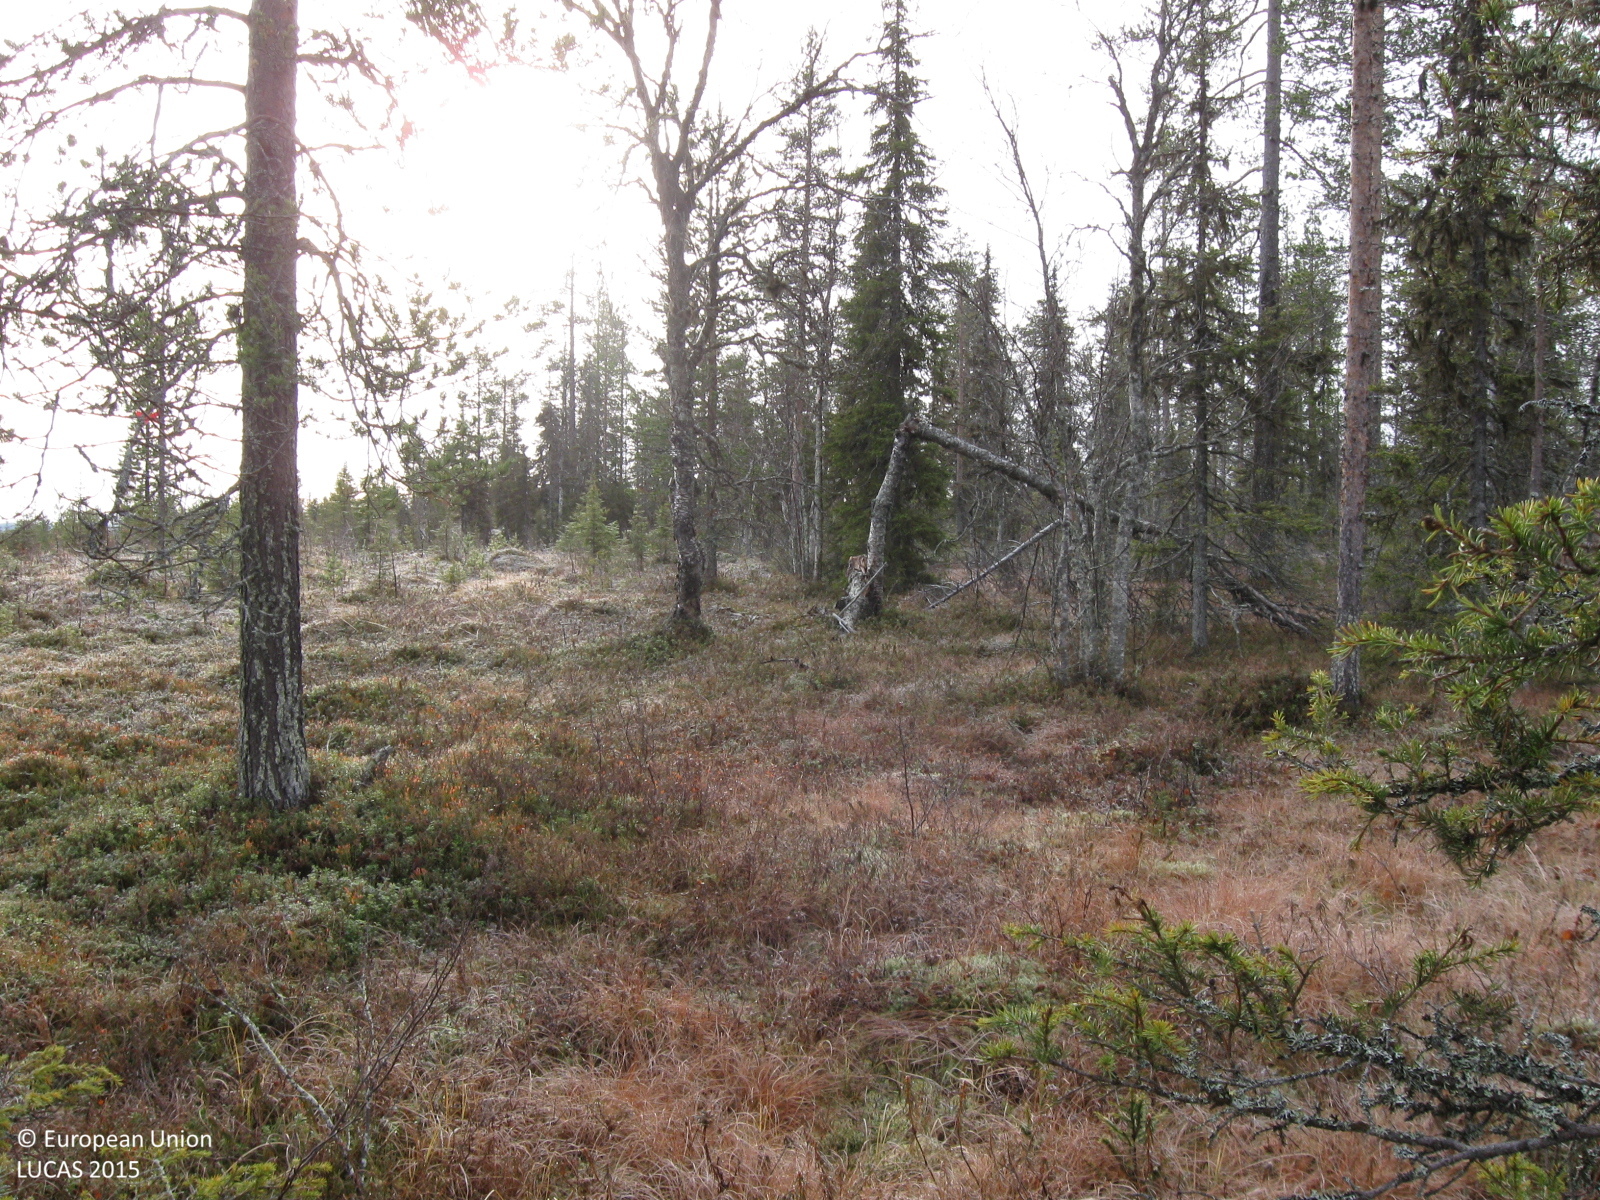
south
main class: Woodland
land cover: Pine dominated coniferous woodland
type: mire and swamp forests
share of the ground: 25 - 50 %
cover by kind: coniferous forest trees 35 %, herbaceous plants 30 %, shrubs 15 %, broadleaved forest trees 10 %, lichens and mosses 10 %
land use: Forestry
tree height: > 5 m
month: October
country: SE
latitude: 66.5031
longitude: 21.5383
